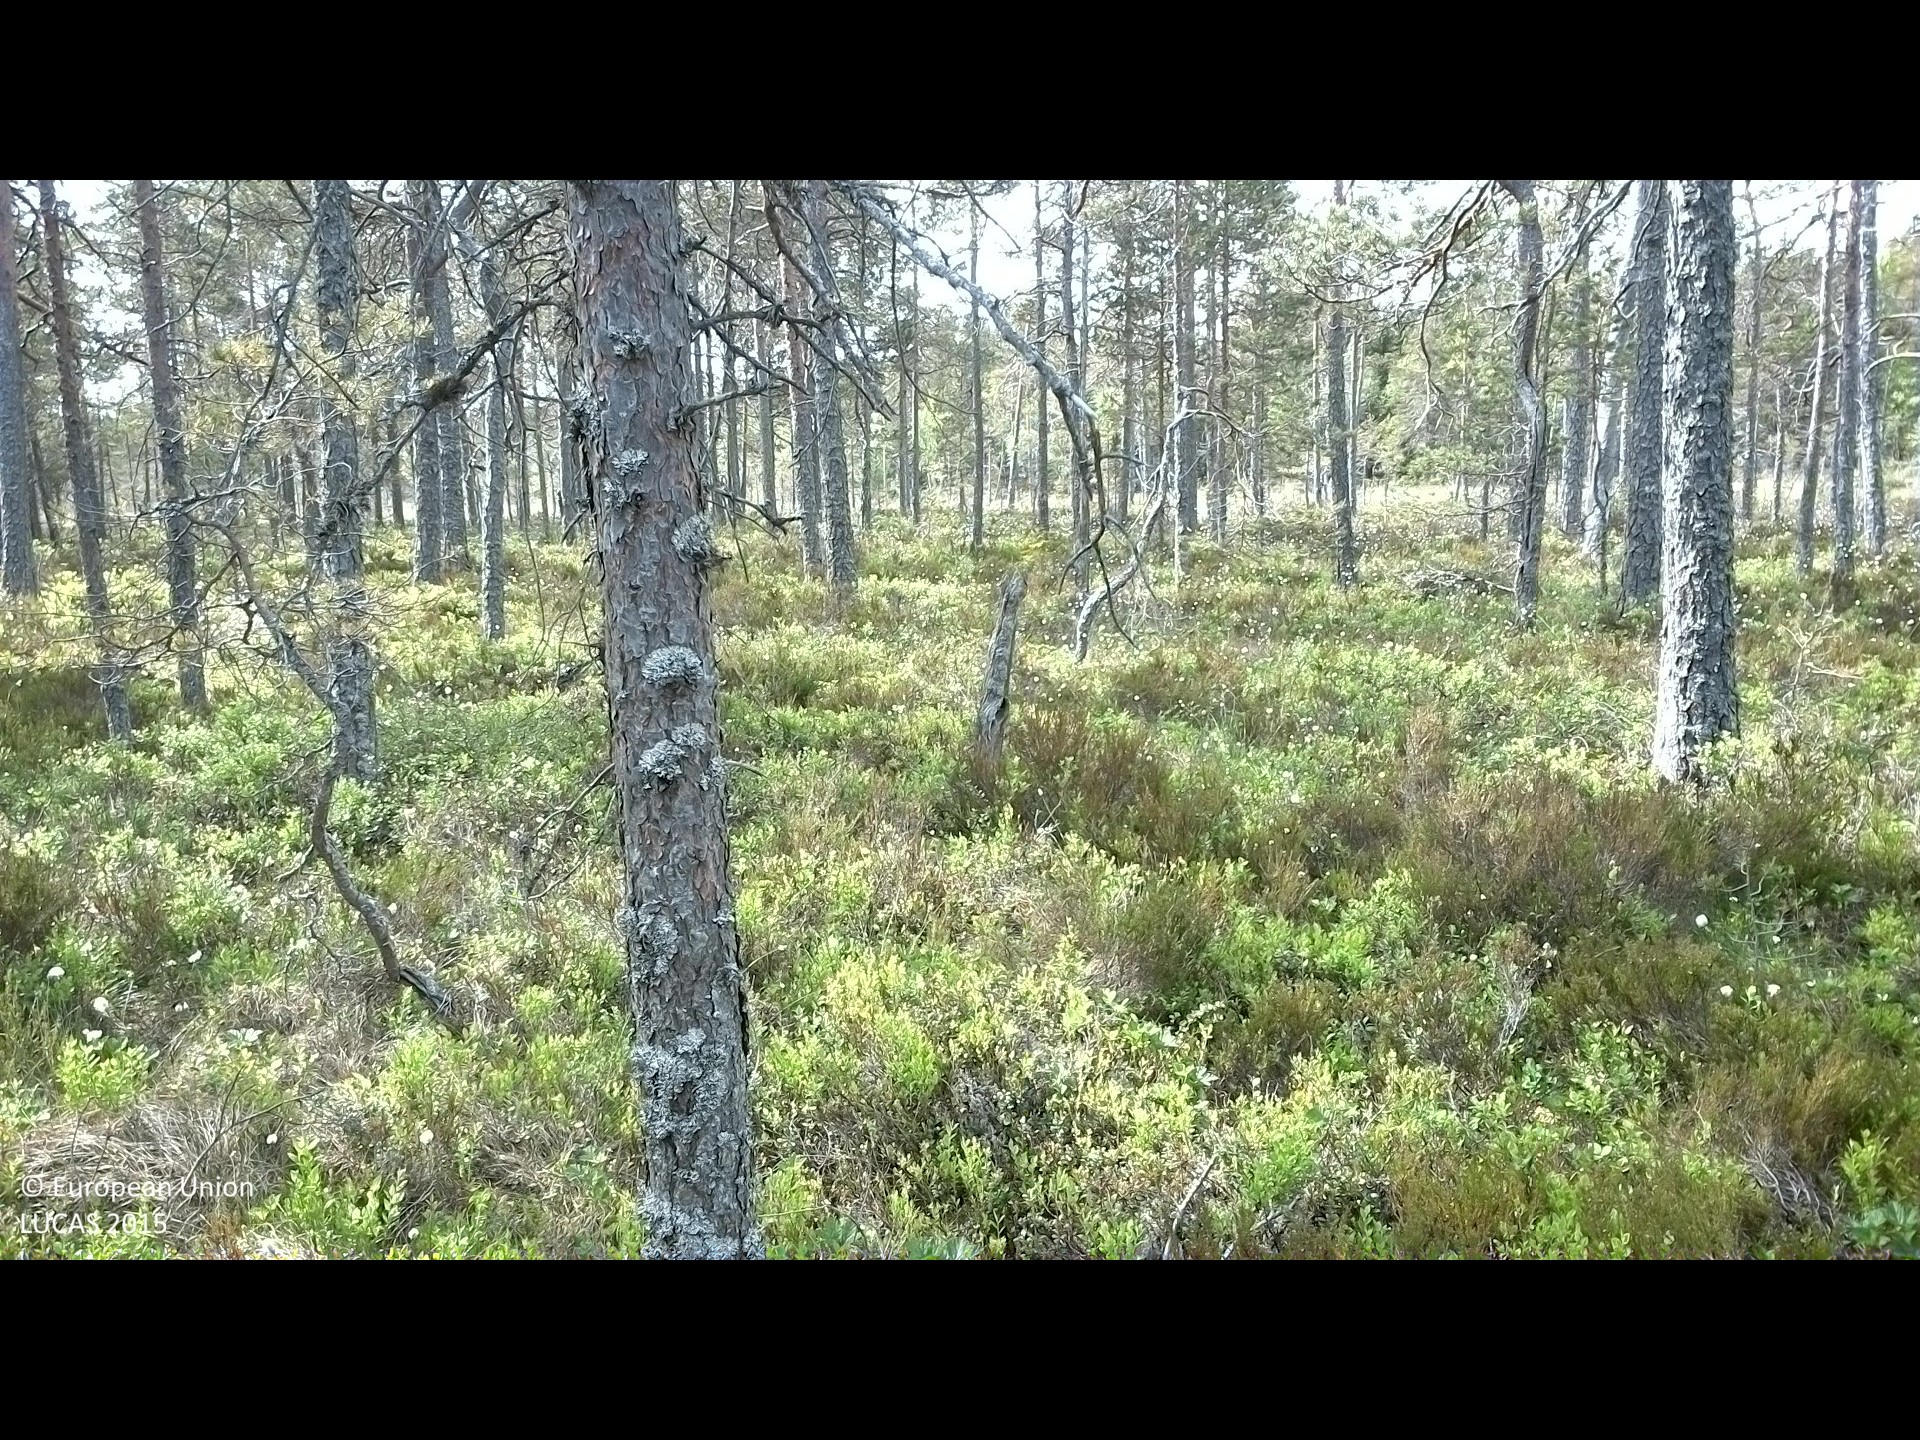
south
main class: Woodland
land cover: Pine dominated coniferous woodland
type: mire and swamp forests
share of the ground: 10 - 25 %
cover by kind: herbaceous plants 35 %, coniferous forest trees 25 %, shrubs 25 %, lichens and mosses 15 %
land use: Forestry
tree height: > 5 m
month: June
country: SE
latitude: 62.2399
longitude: 17.5837
